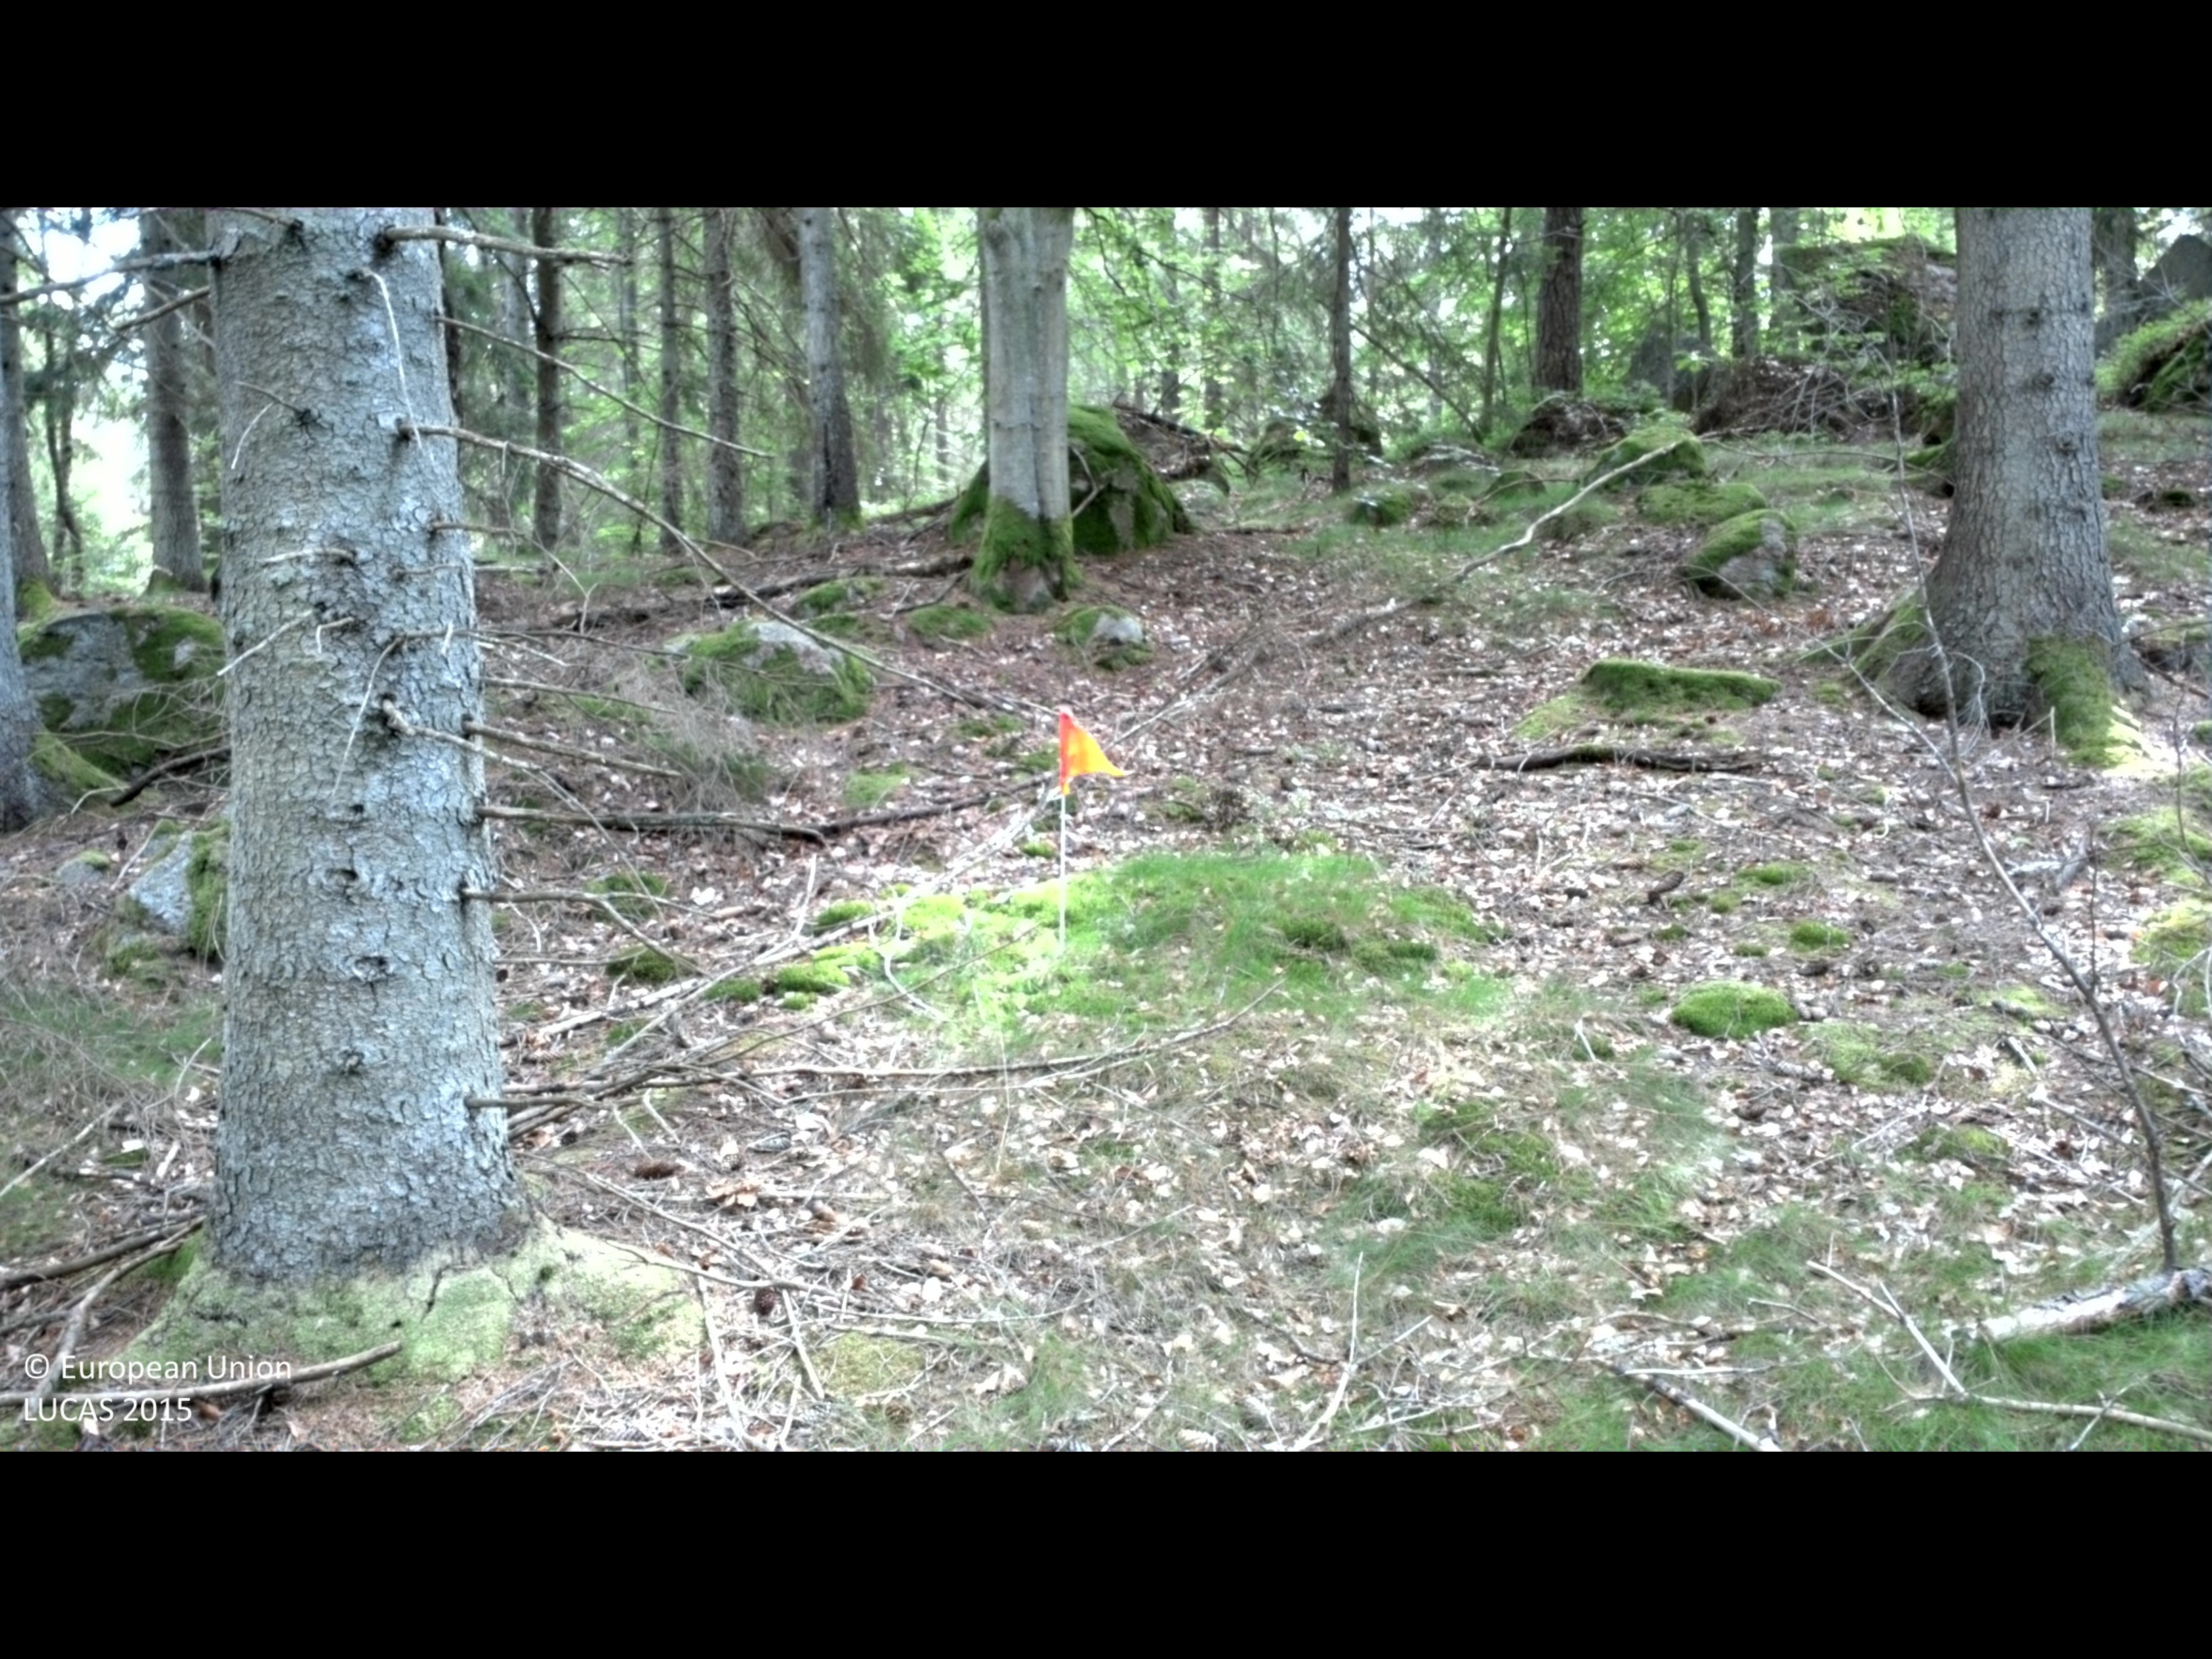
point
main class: Woodland
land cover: Spruce dominated coniferous woodland
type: boreal forest
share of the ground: 50 - 75 %
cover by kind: coniferous forest trees 55 %, lichens and mosses 35 %, broadleaved forest trees 5 %, herbaceous plants 5 %
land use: Forestry
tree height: > 5 m
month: August
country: SE
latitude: 56.3060
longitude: 15.8674
